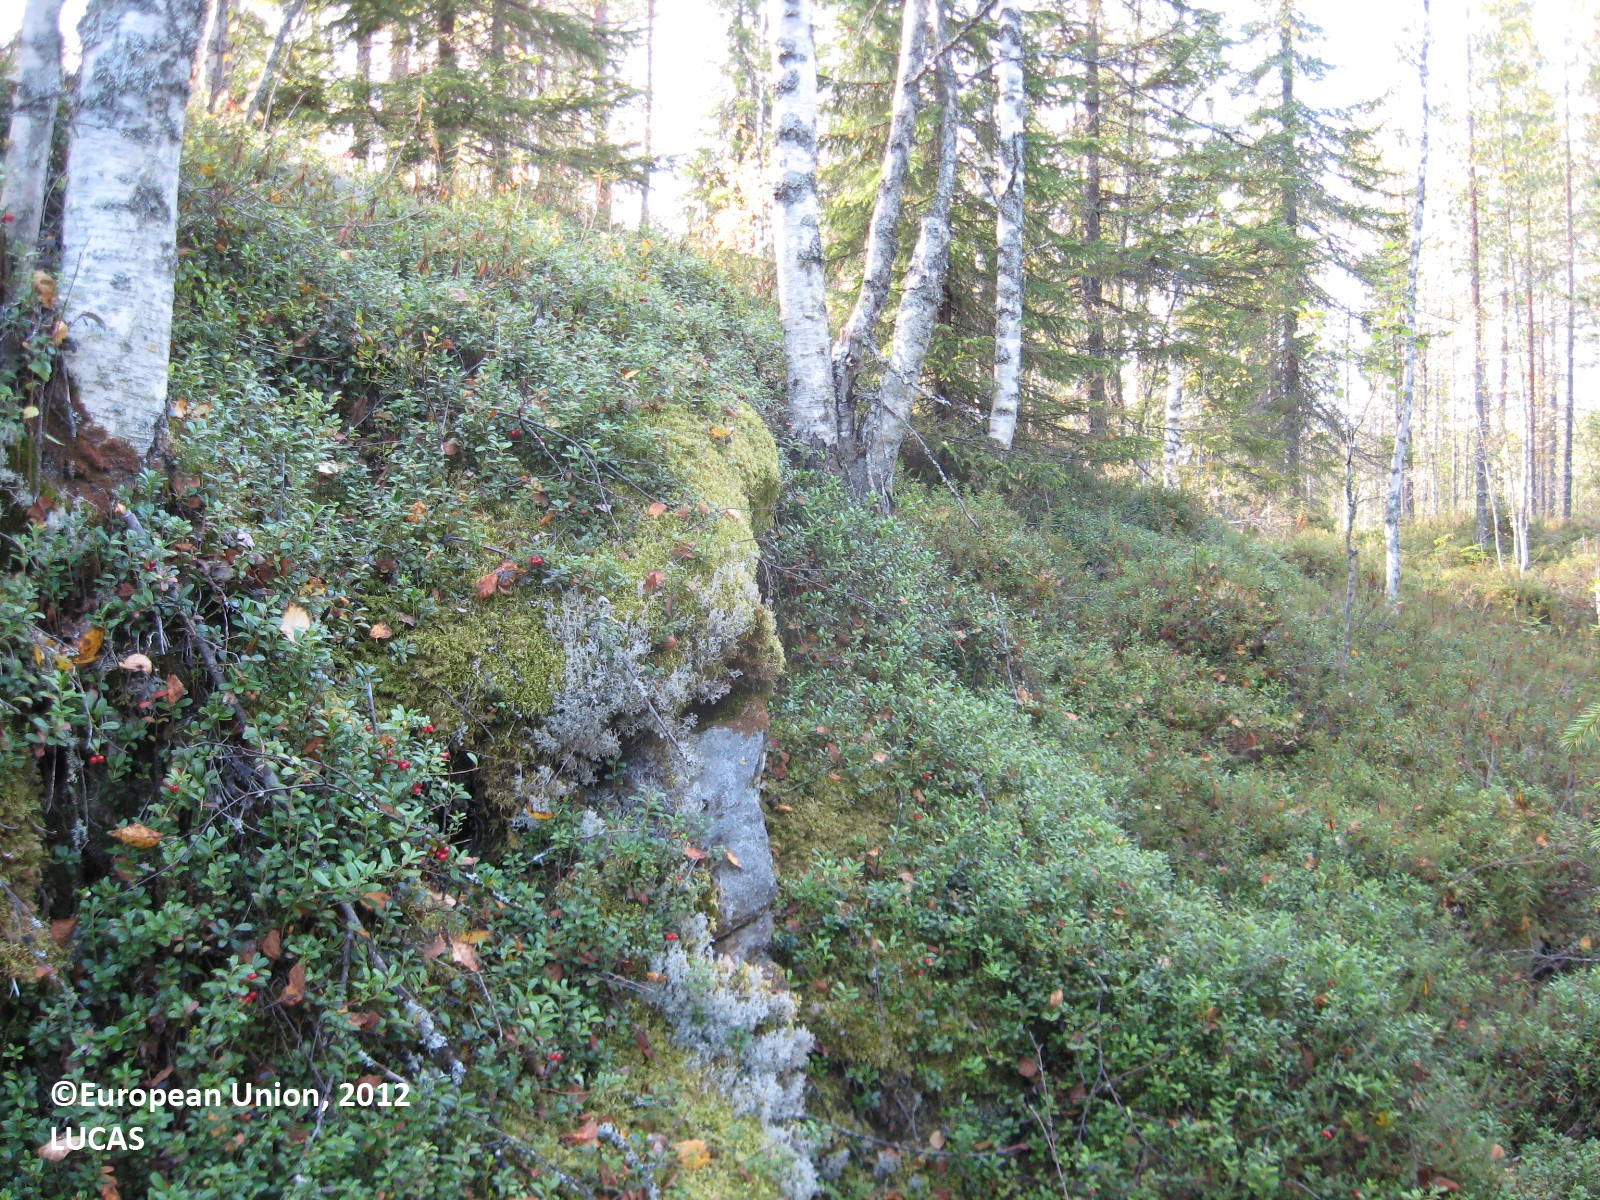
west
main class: Woodland
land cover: Other mixed woodland
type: boreal forest
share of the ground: 50 - 75 %
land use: Forestry
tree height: > 5 m
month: August
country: FI
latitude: 63.9268
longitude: 28.5173
